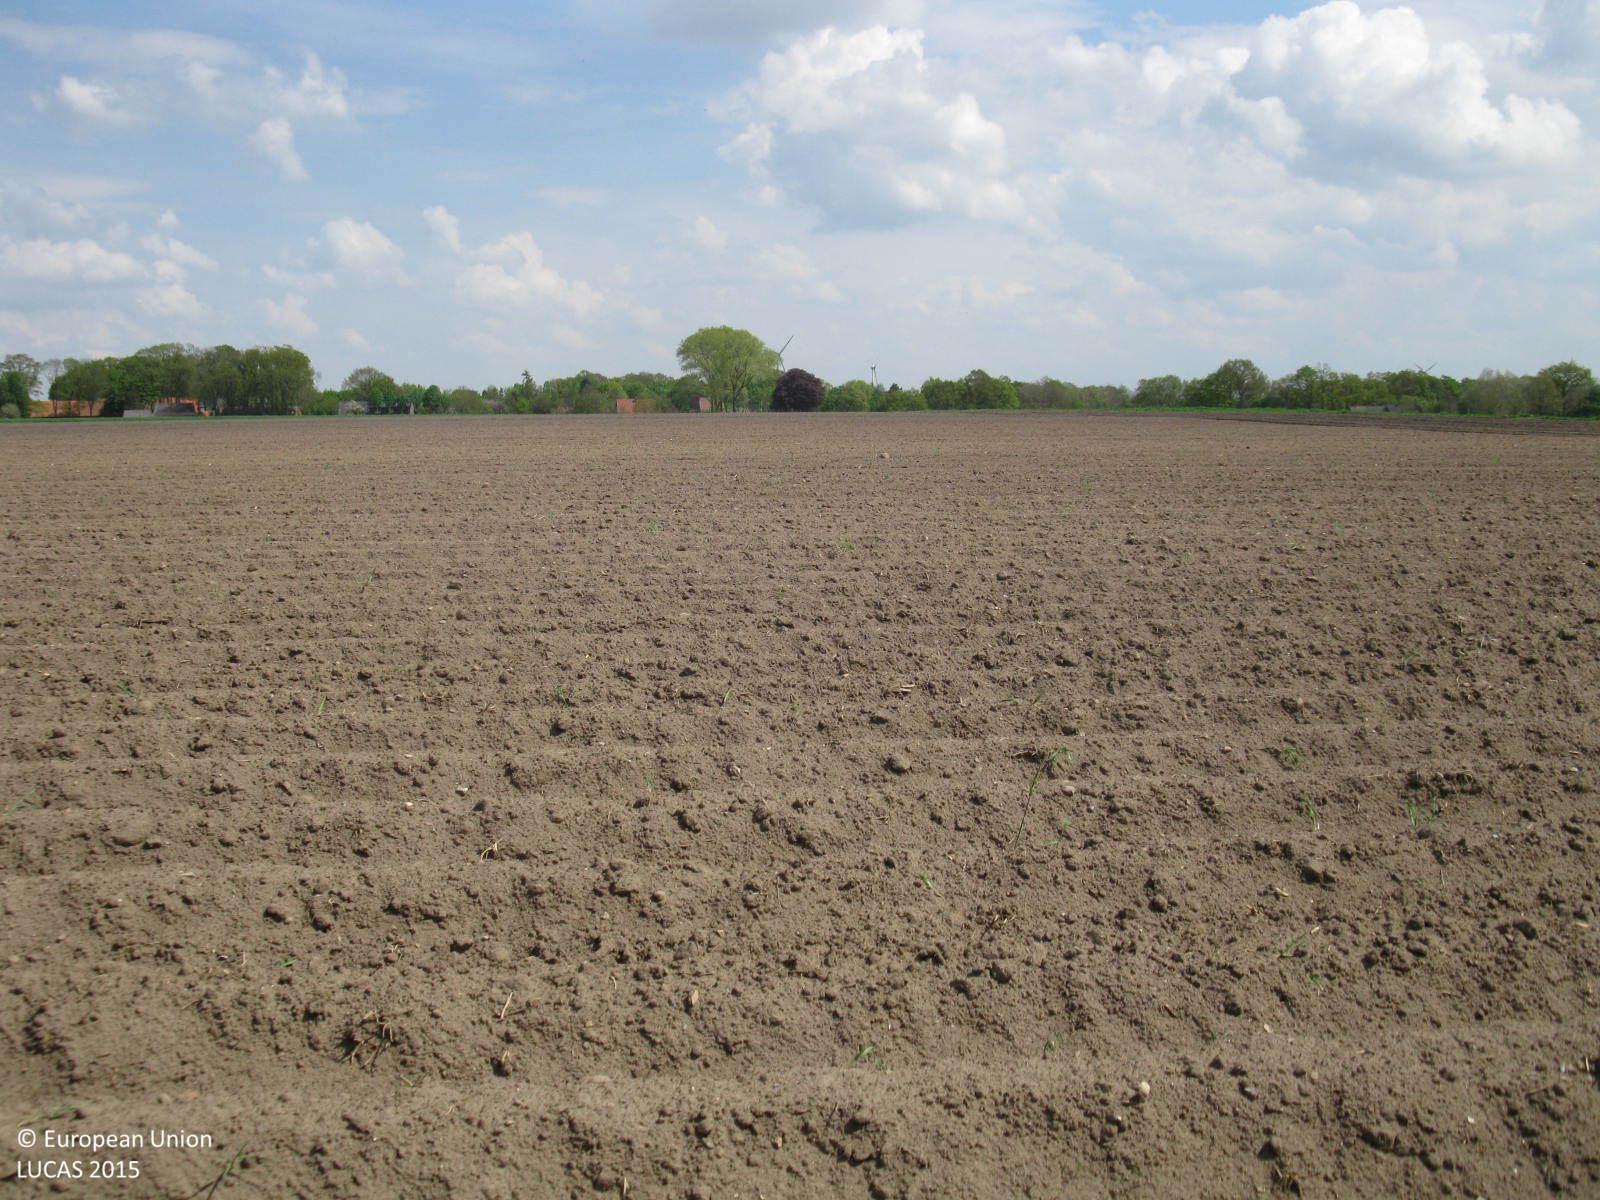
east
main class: Cropland
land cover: Potatoes
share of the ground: < 10 %
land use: Agriculture (excluding fallow land and kitchen gardens)
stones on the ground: < 10 %
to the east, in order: Potatoes
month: May
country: DE
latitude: 52.8091
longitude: 7.9385
